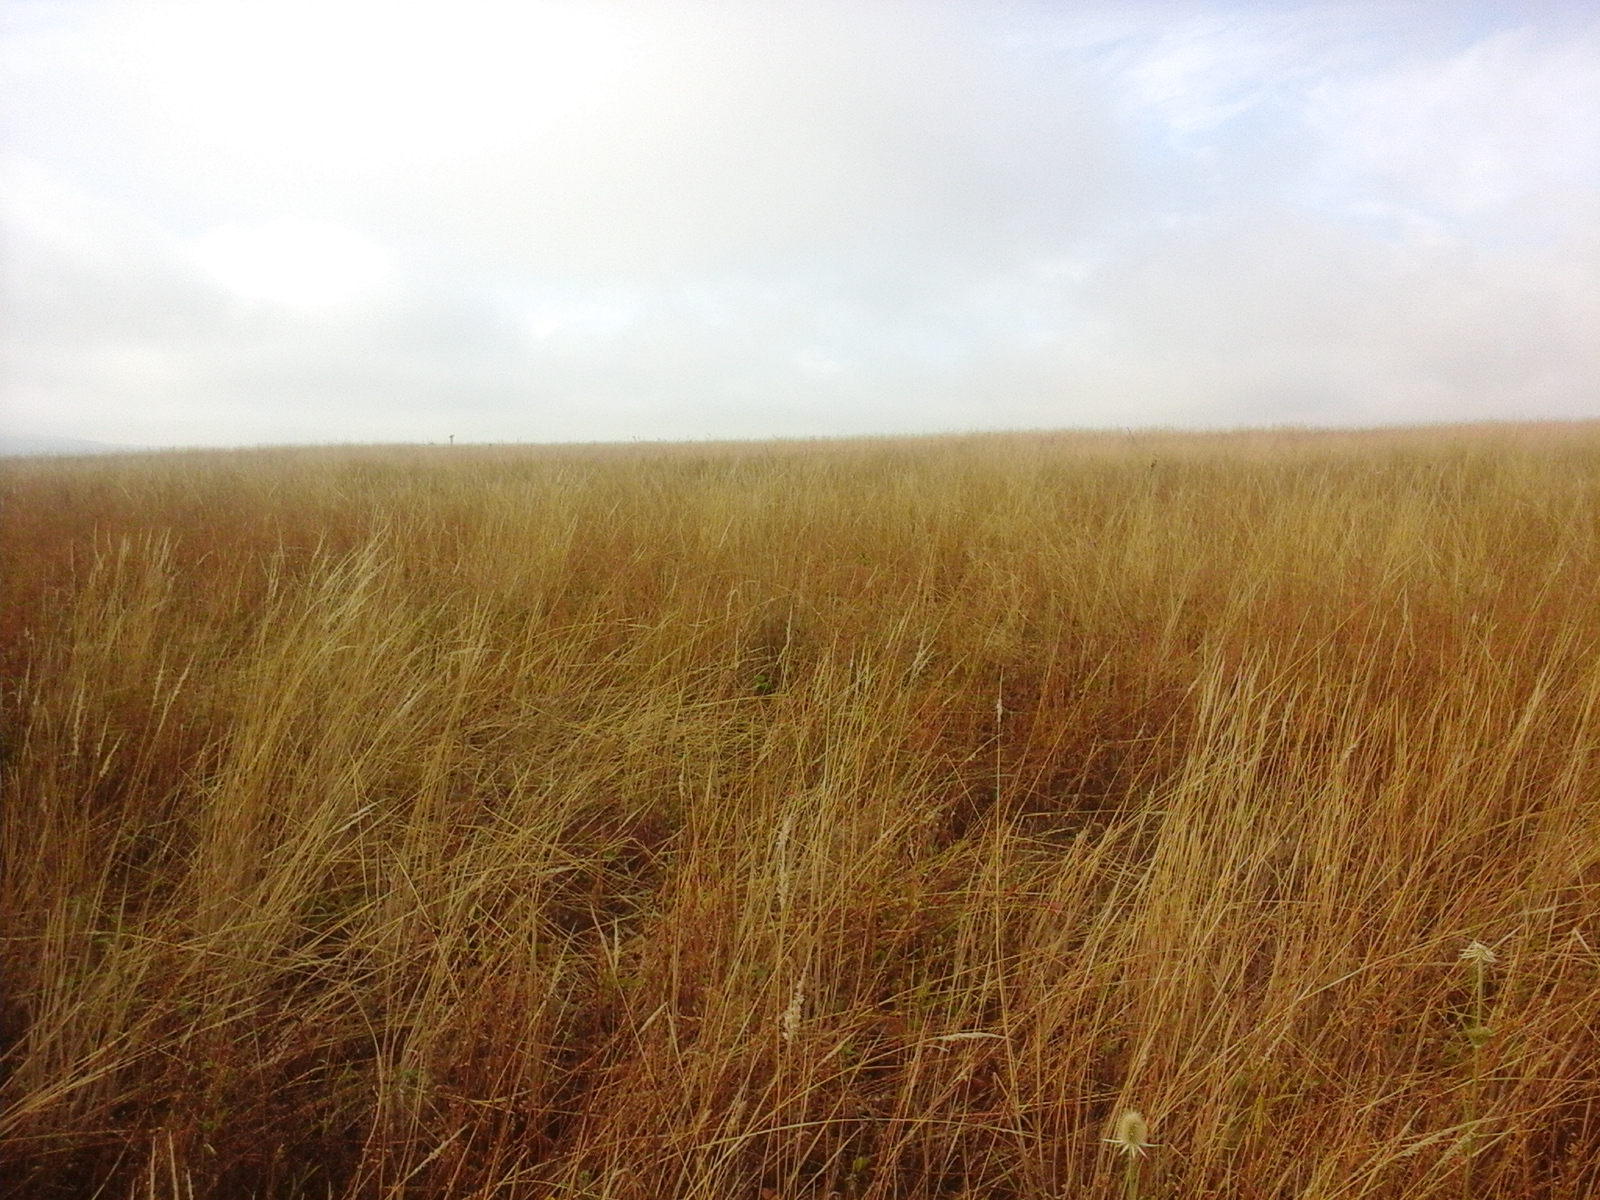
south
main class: Grassland
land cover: Grassland without tree/shrub cover
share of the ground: > 75 %
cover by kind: herbaceous plants 100 %
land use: Agriculture (excluding fallow land and kitchen gardens)
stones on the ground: < 10 %
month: August
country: RO
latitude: 45.1666
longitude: 21.6479
